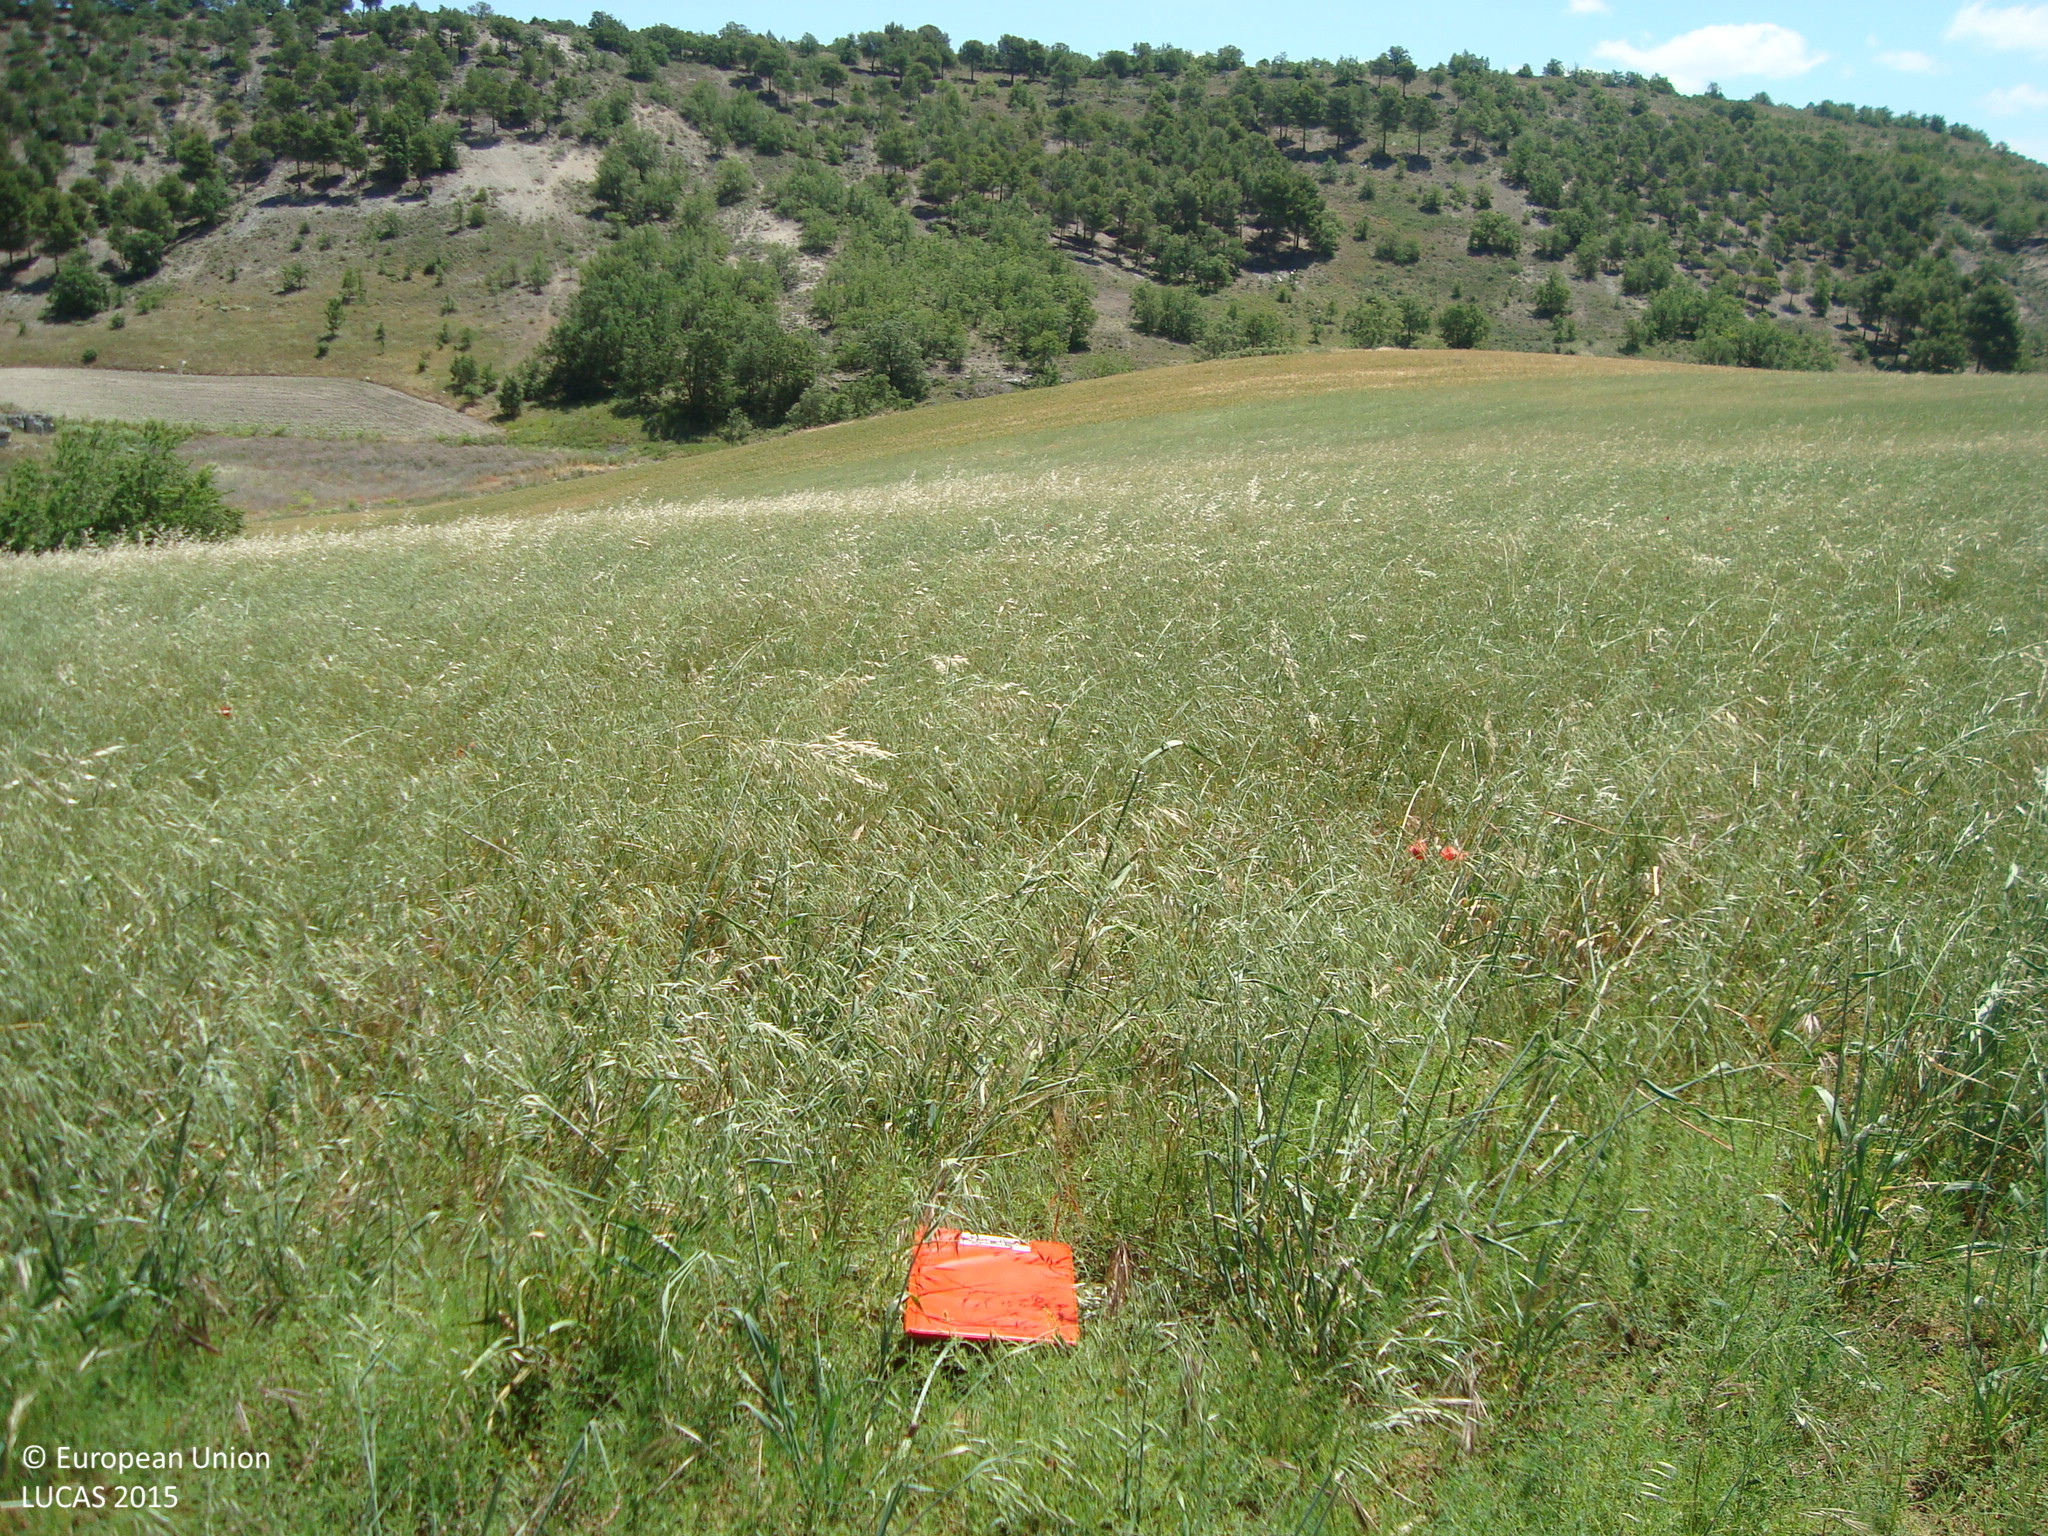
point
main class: Cropland
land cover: Oats
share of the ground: > 75 %
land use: Agriculture (excluding fallow land and kitchen gardens)
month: June
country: ES
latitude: 41.6666
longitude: -4.1966
